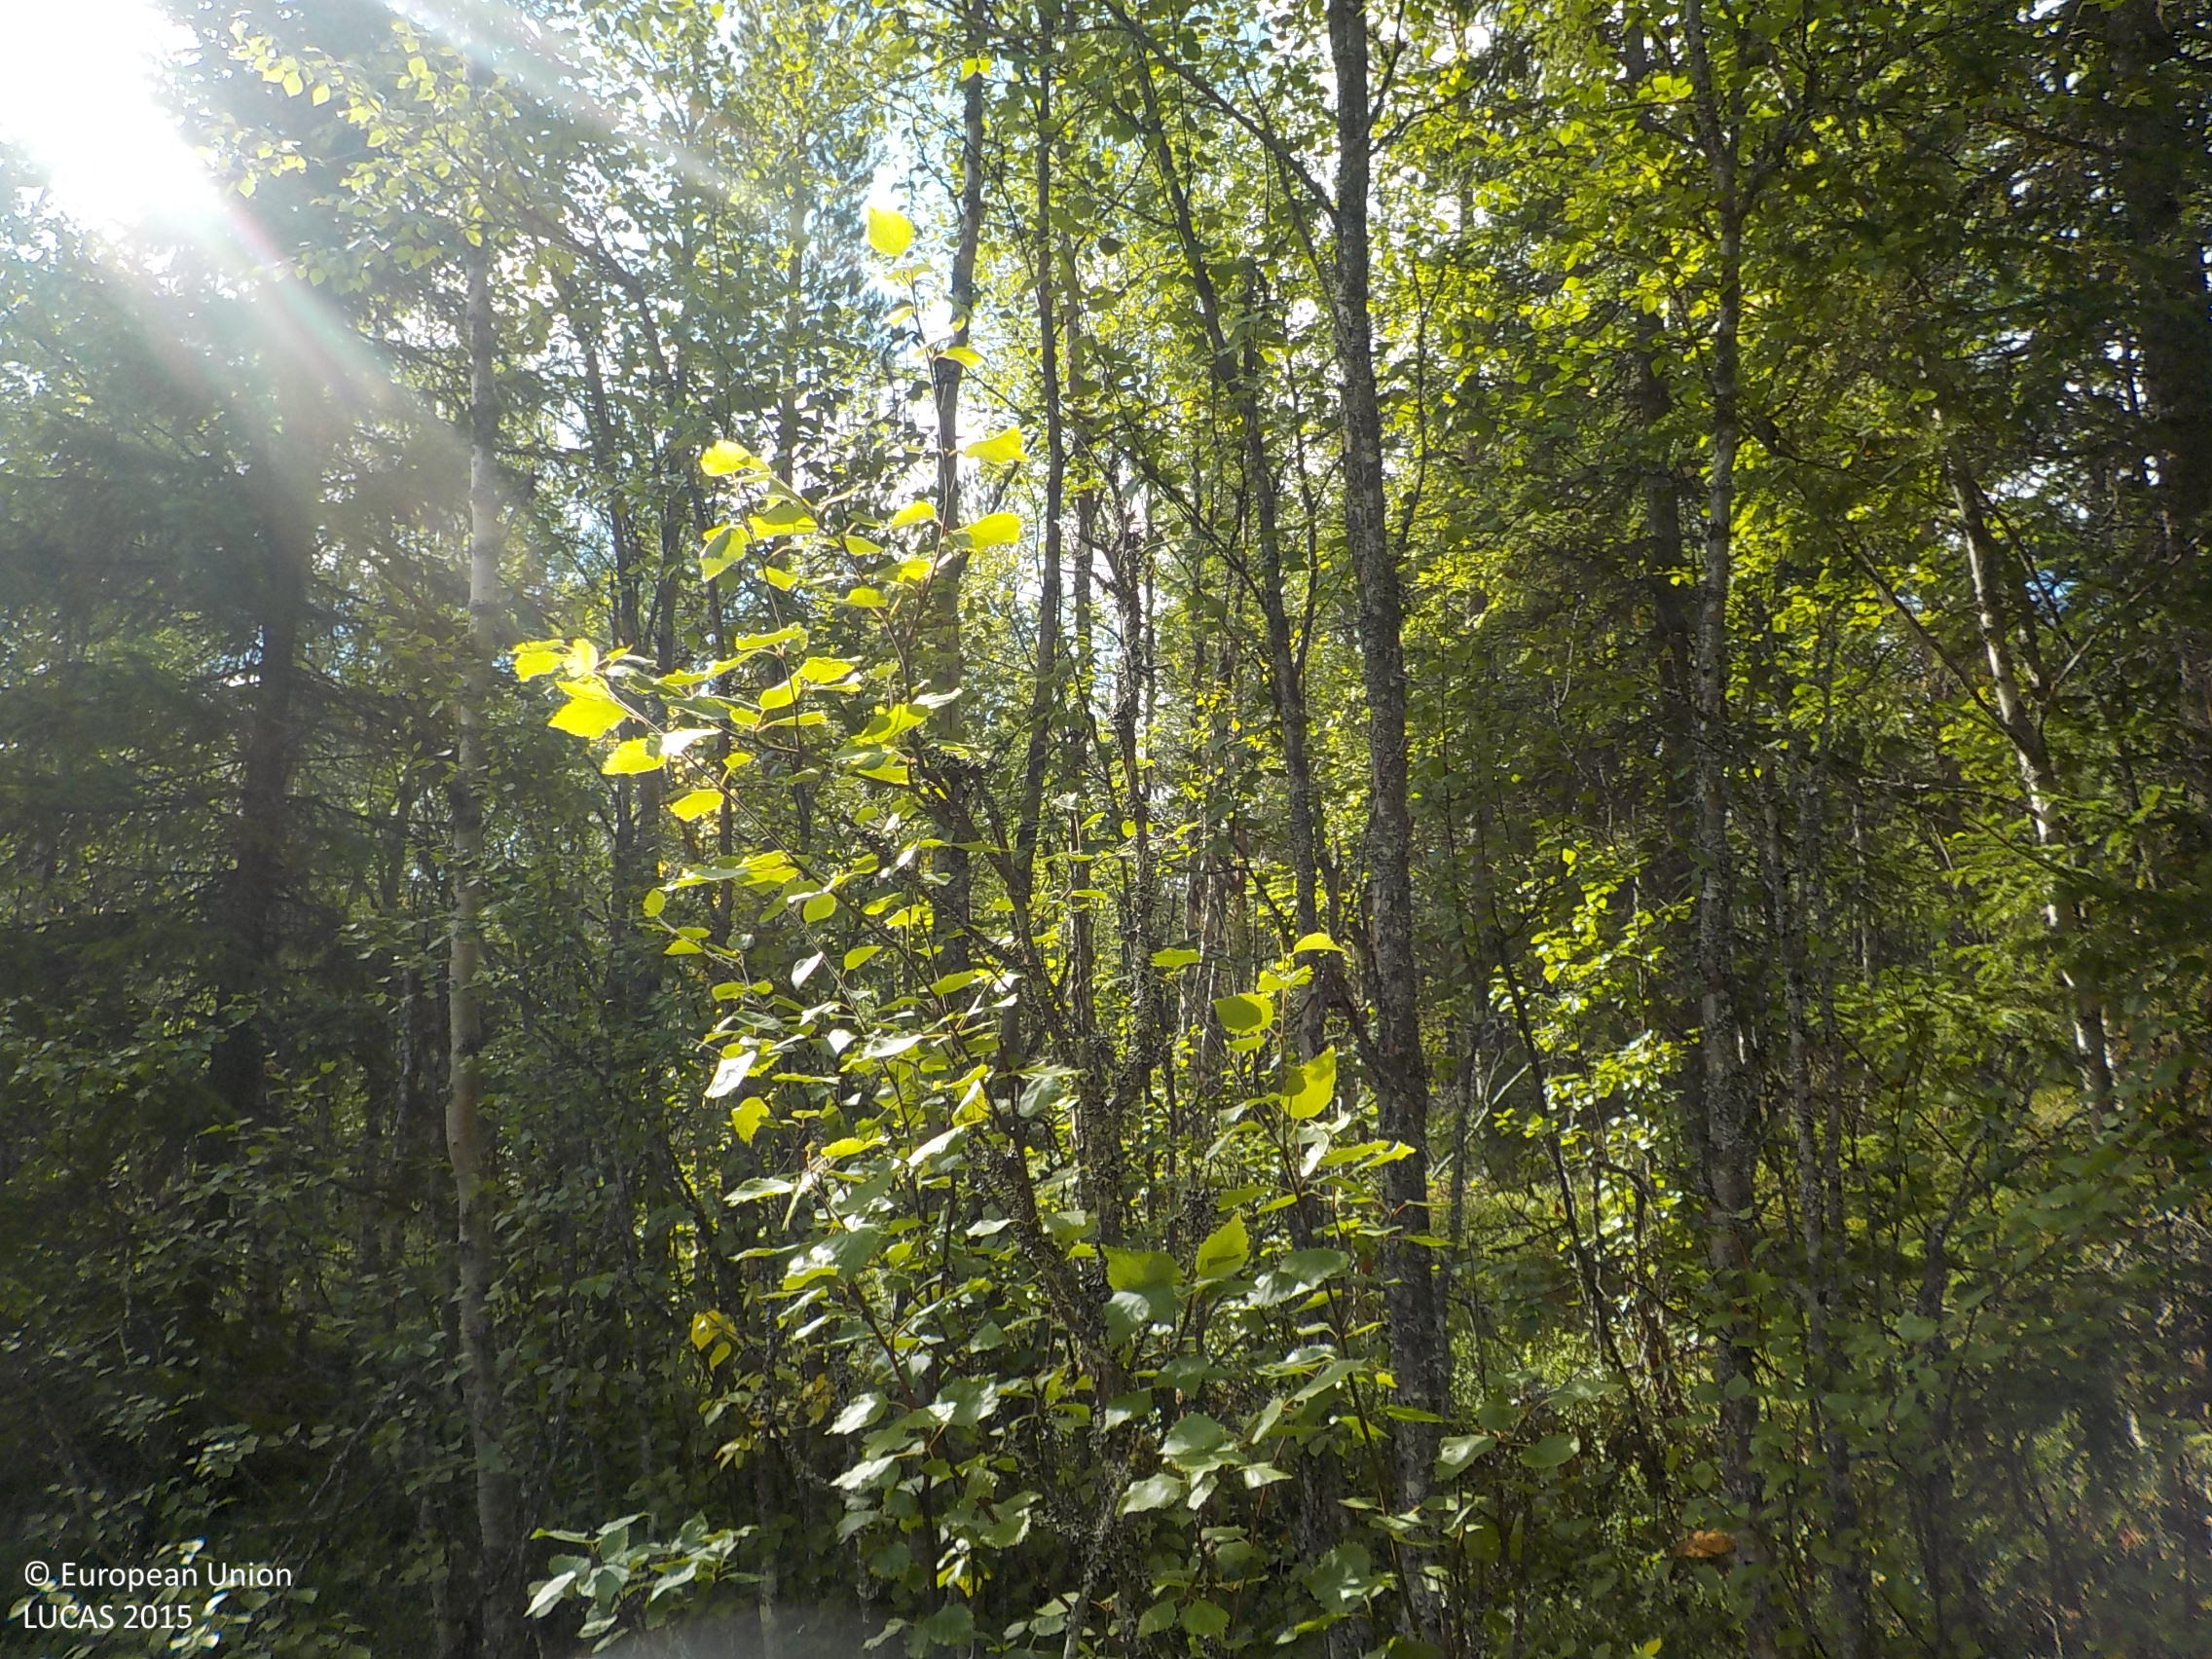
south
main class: Woodland
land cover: Pine dominated mixed woodland
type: boreal forest
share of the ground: > 75 %
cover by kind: coniferous forest trees 50 %, broadleaved forest trees 30 %, shrubs 20 %
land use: Forestry
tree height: > 5 m
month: August
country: SE
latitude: 64.0680
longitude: 17.6562
